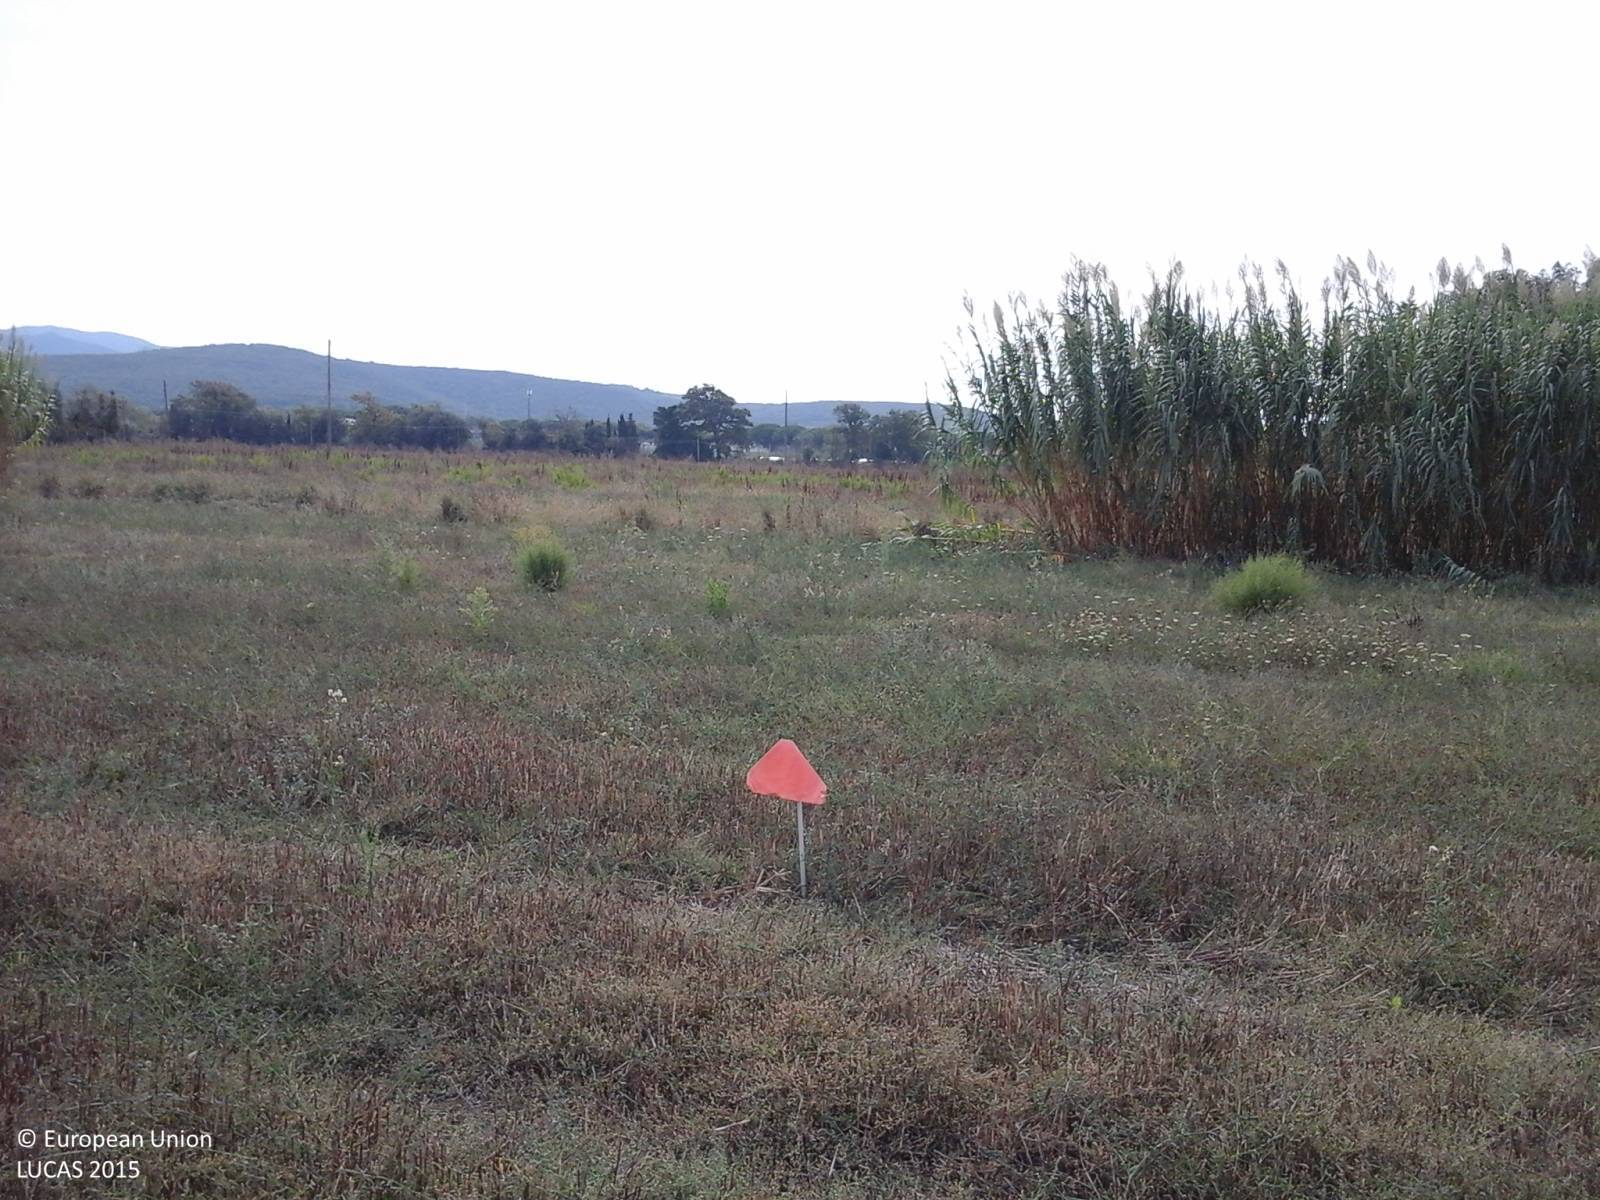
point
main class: Grassland
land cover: Spontaneously vegetated surfaces
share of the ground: > 75 %
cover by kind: herbaceous plants 100 %
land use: Fallow land
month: October
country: IT
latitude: 43.1581
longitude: 10.5517
